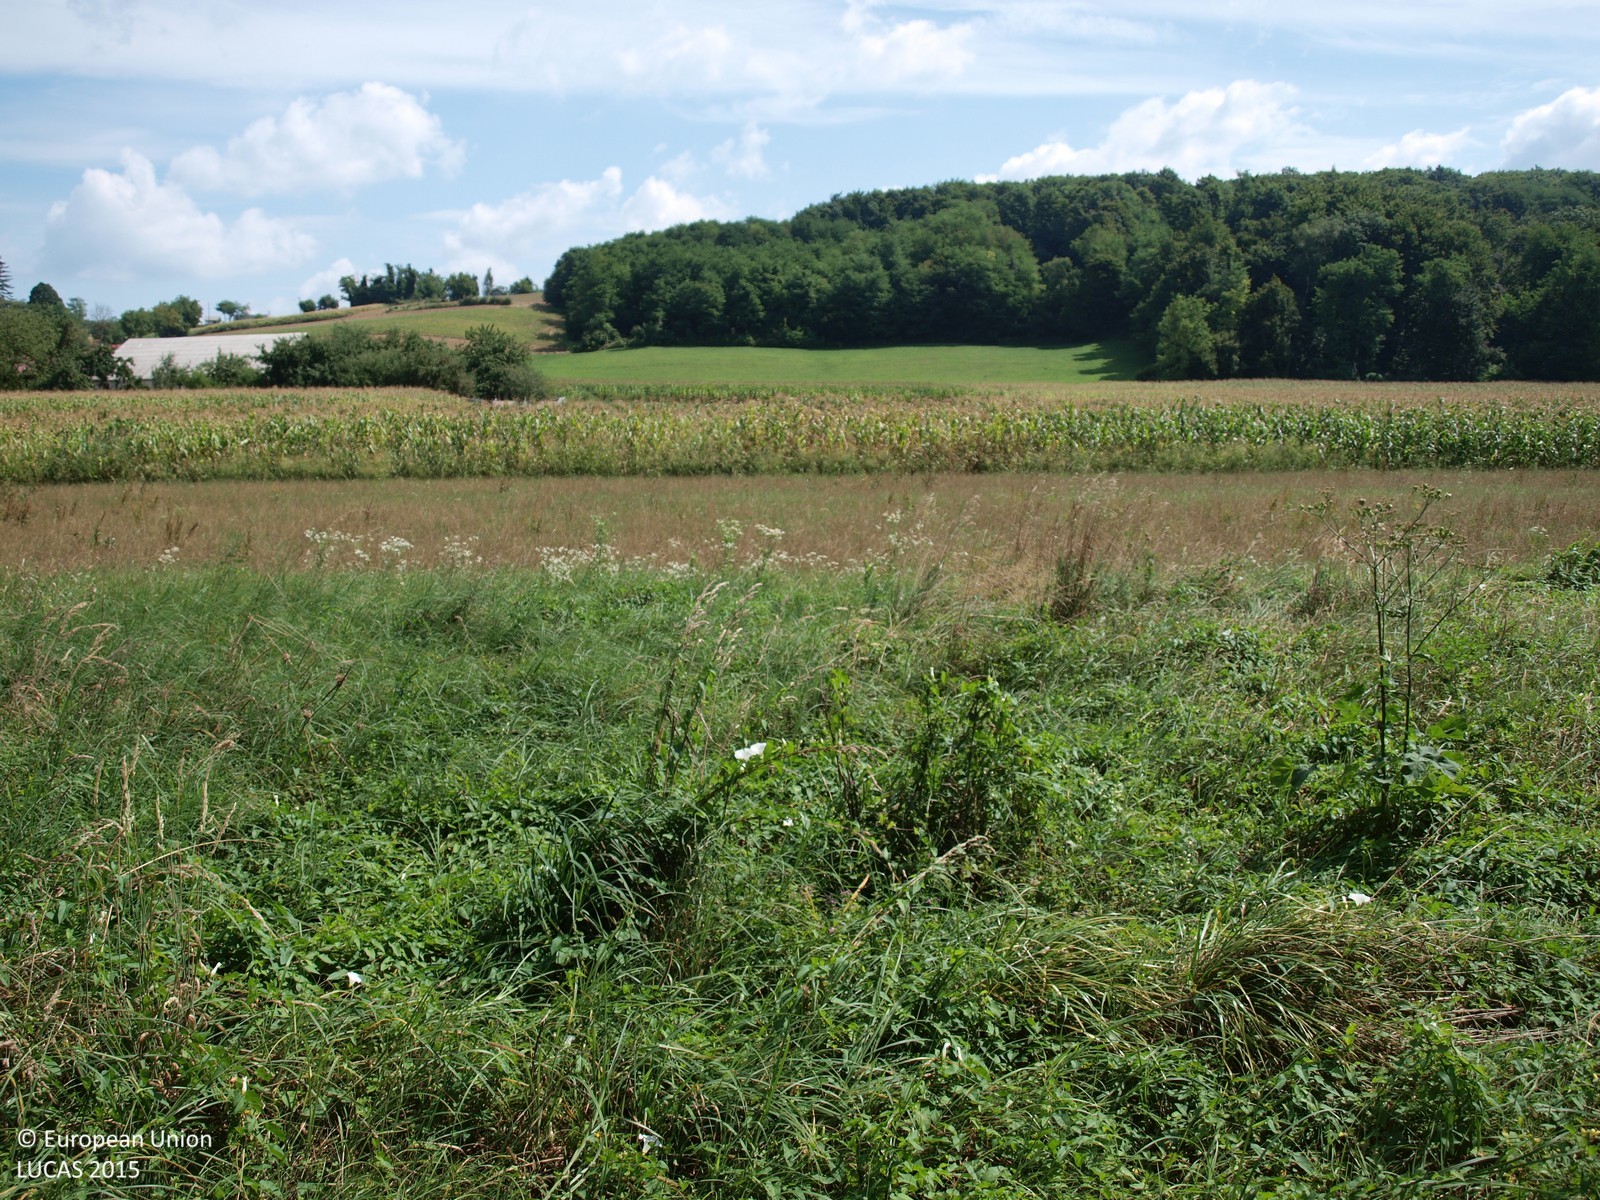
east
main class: Grassland
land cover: Grassland without tree/shrub cover
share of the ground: > 75 %
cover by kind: herbaceous plants 100 %
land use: Agriculture (excluding fallow land and kitchen gardens)
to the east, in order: Grassland without tree/shrub cover; Maize; Tracks; Grassland without tree/shrub cover; Maize; Grassland without tree/shrub cover; Broadleaved woodland
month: August
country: HR
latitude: 46.1168
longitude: 16.5087
